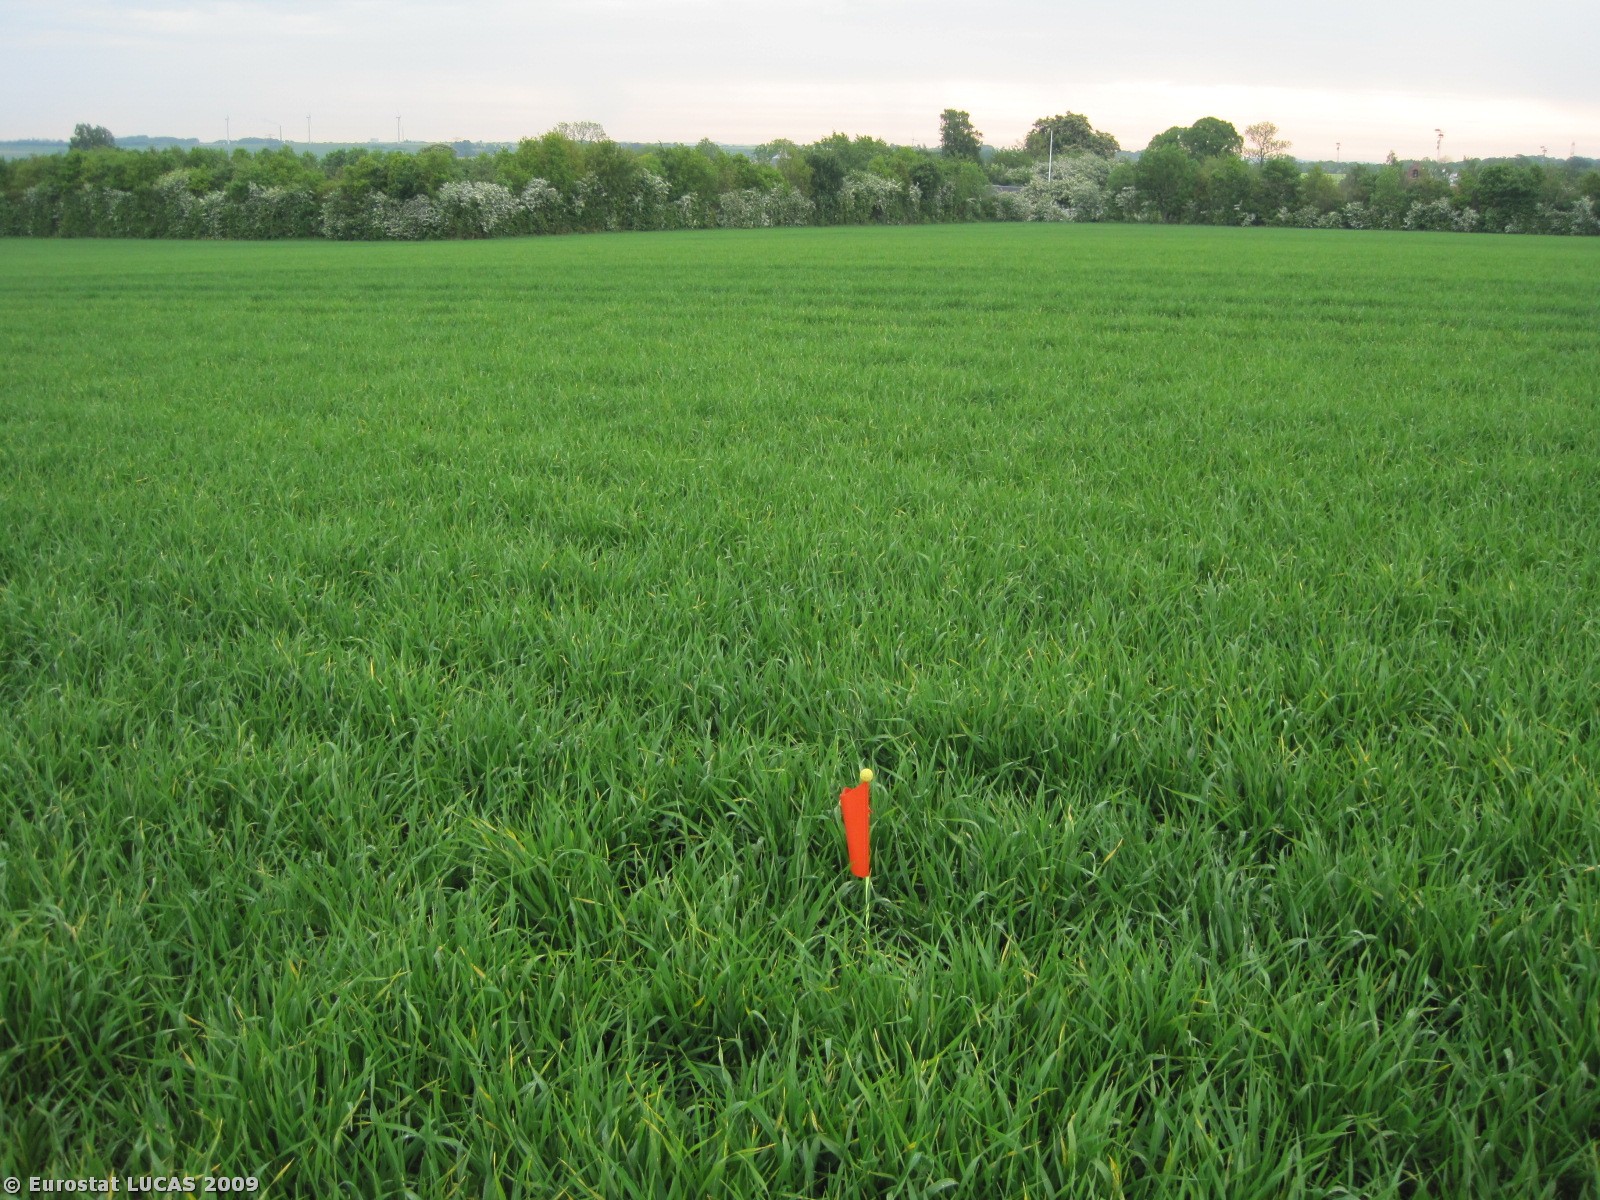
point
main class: Cropland
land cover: Barley
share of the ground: > 75 %
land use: Agriculture (excluding fallow land and kitchen gardens)
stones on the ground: < 10 %
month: May
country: DK
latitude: 56.4034
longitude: 9.9838
